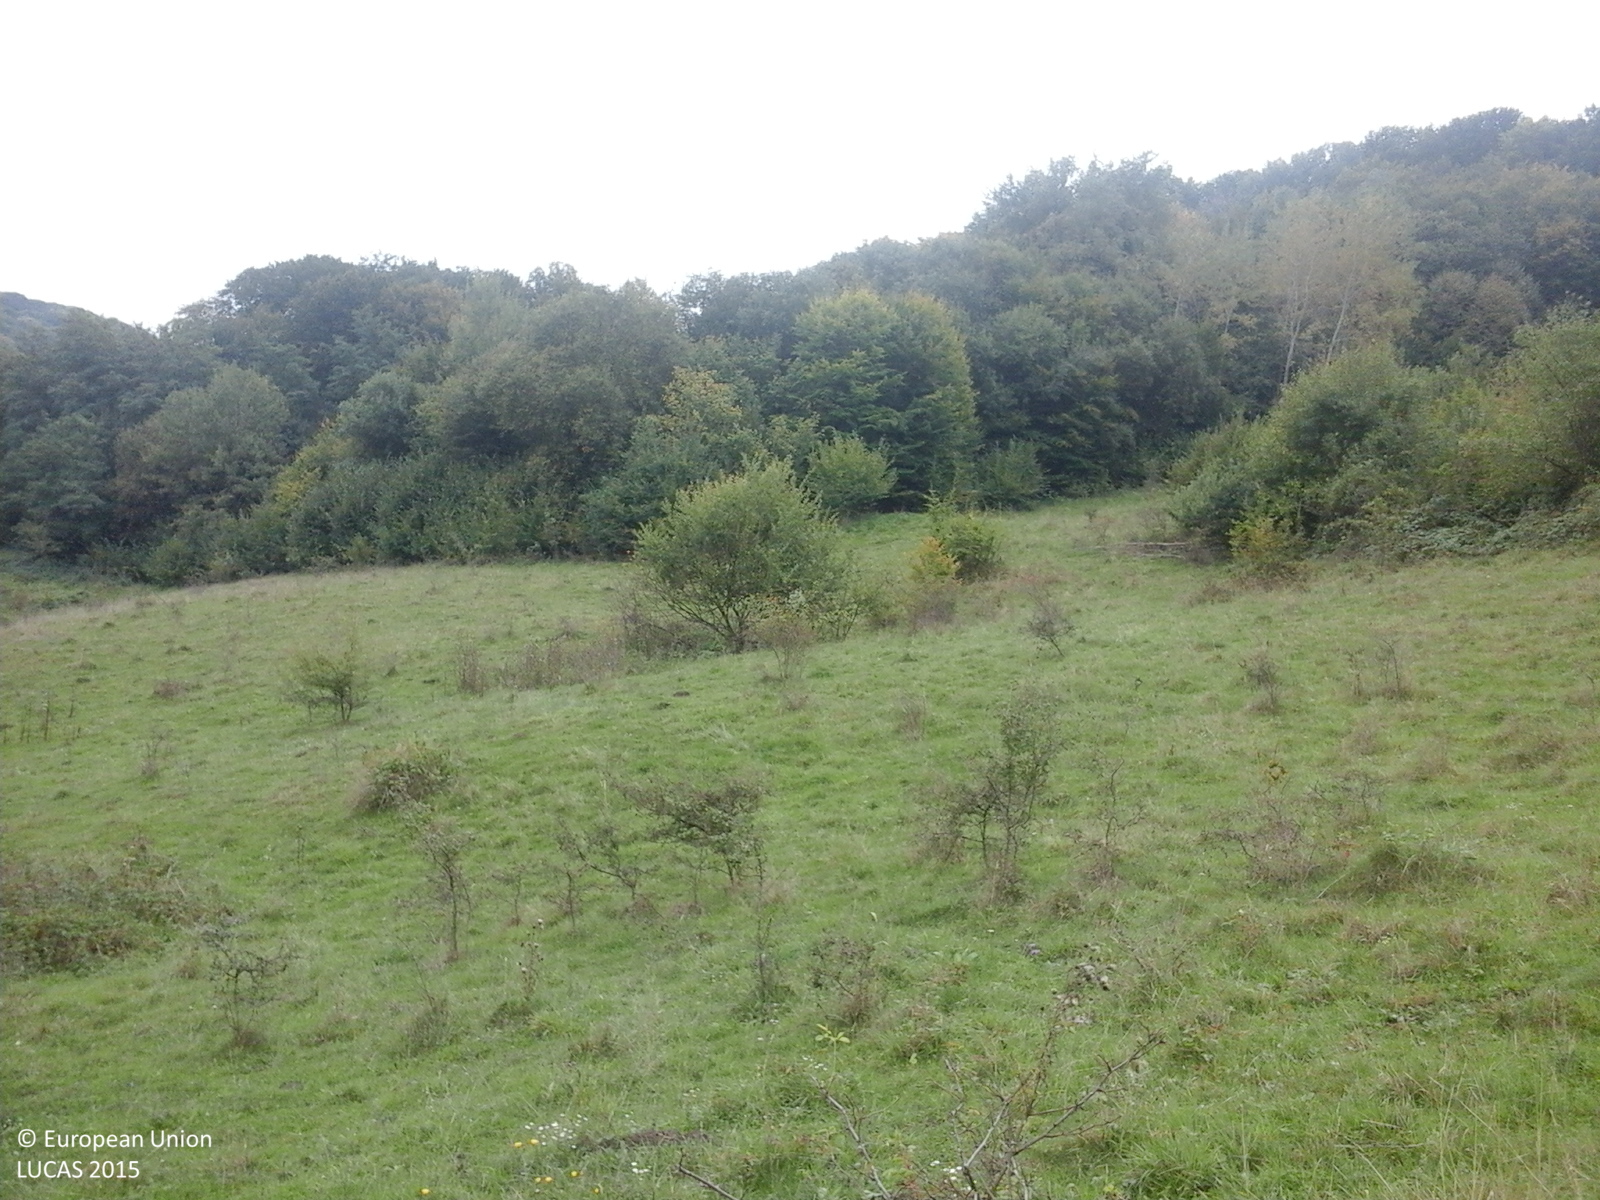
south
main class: Grassland
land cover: Grassland with sparse tree/shrub cover
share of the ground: > 75 %
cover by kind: herbaceous plants 85 %, shrubs 10 %, broadleaved forest trees 5 %
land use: Agriculture (excluding fallow land and kitchen gardens)
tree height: < 5 m
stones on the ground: < 10 %
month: October
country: RO
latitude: 46.0983
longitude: 24.6919
